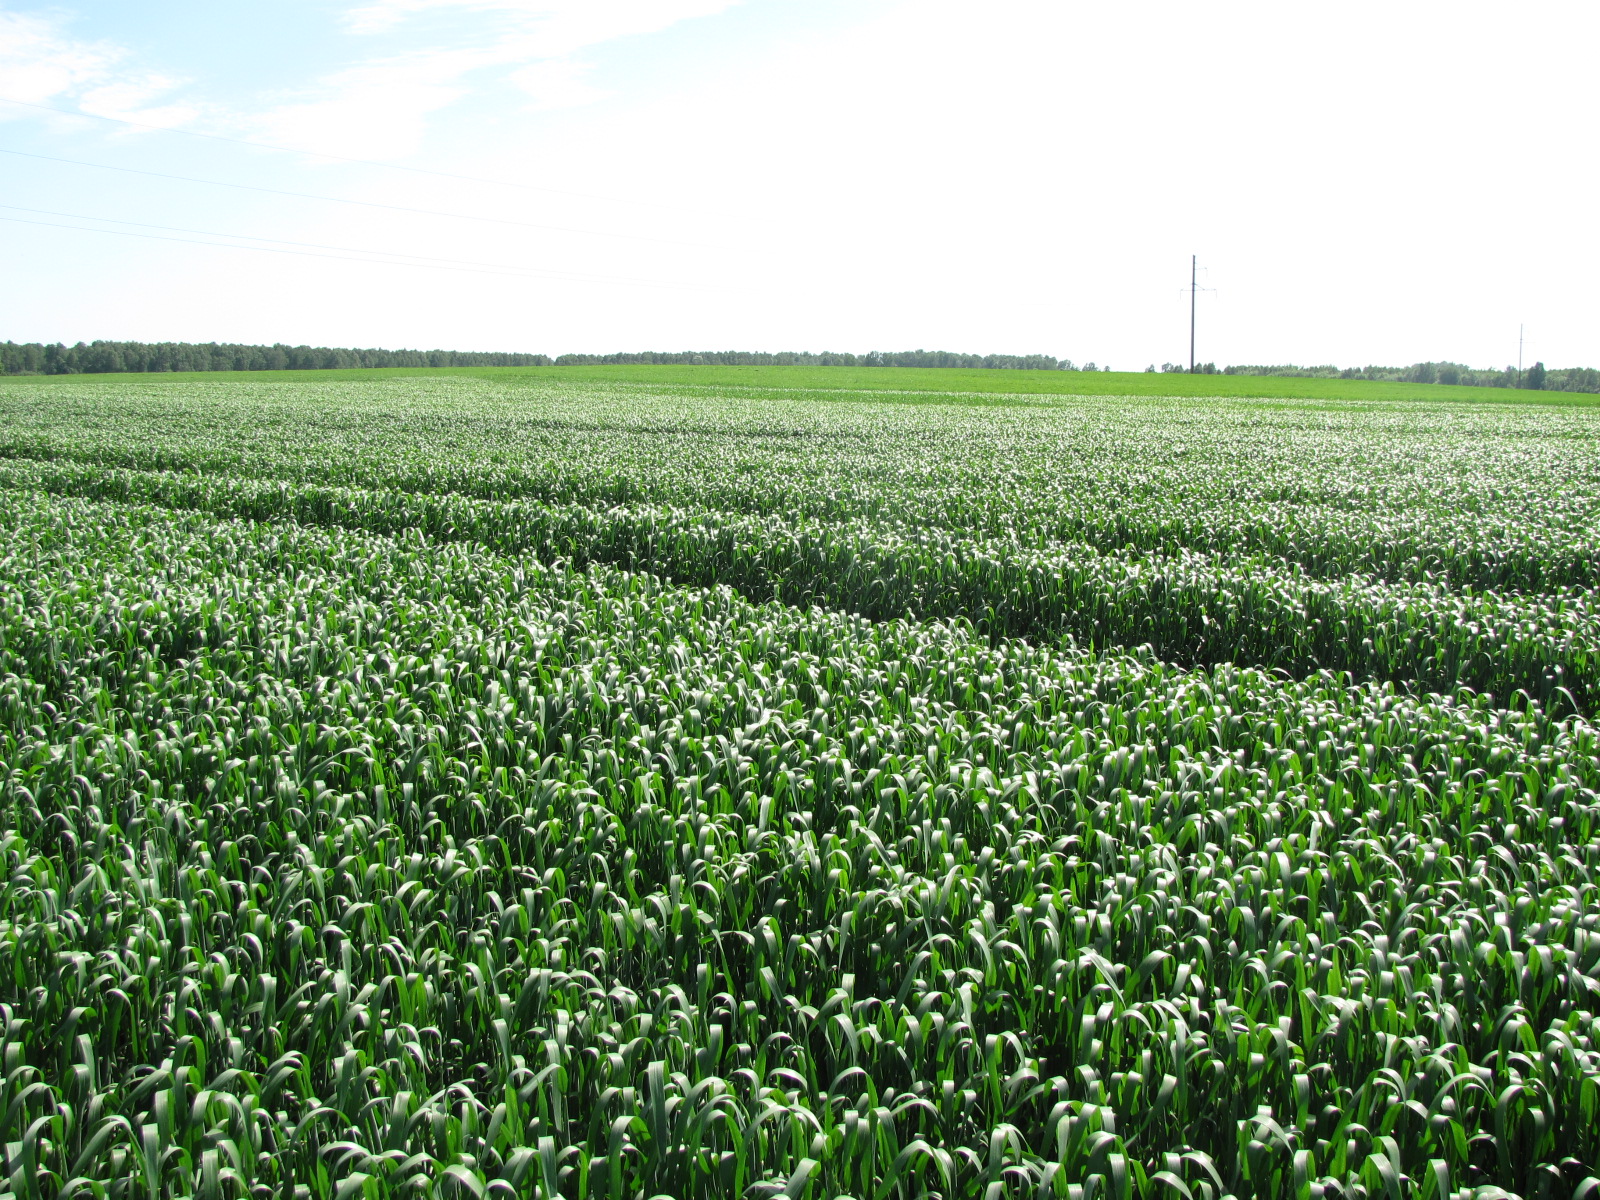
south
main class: Cropland
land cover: Common wheat
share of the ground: > 75 %
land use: Agriculture (excluding fallow land and kitchen gardens)
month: June
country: LV
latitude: 56.4790
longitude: 24.2984
